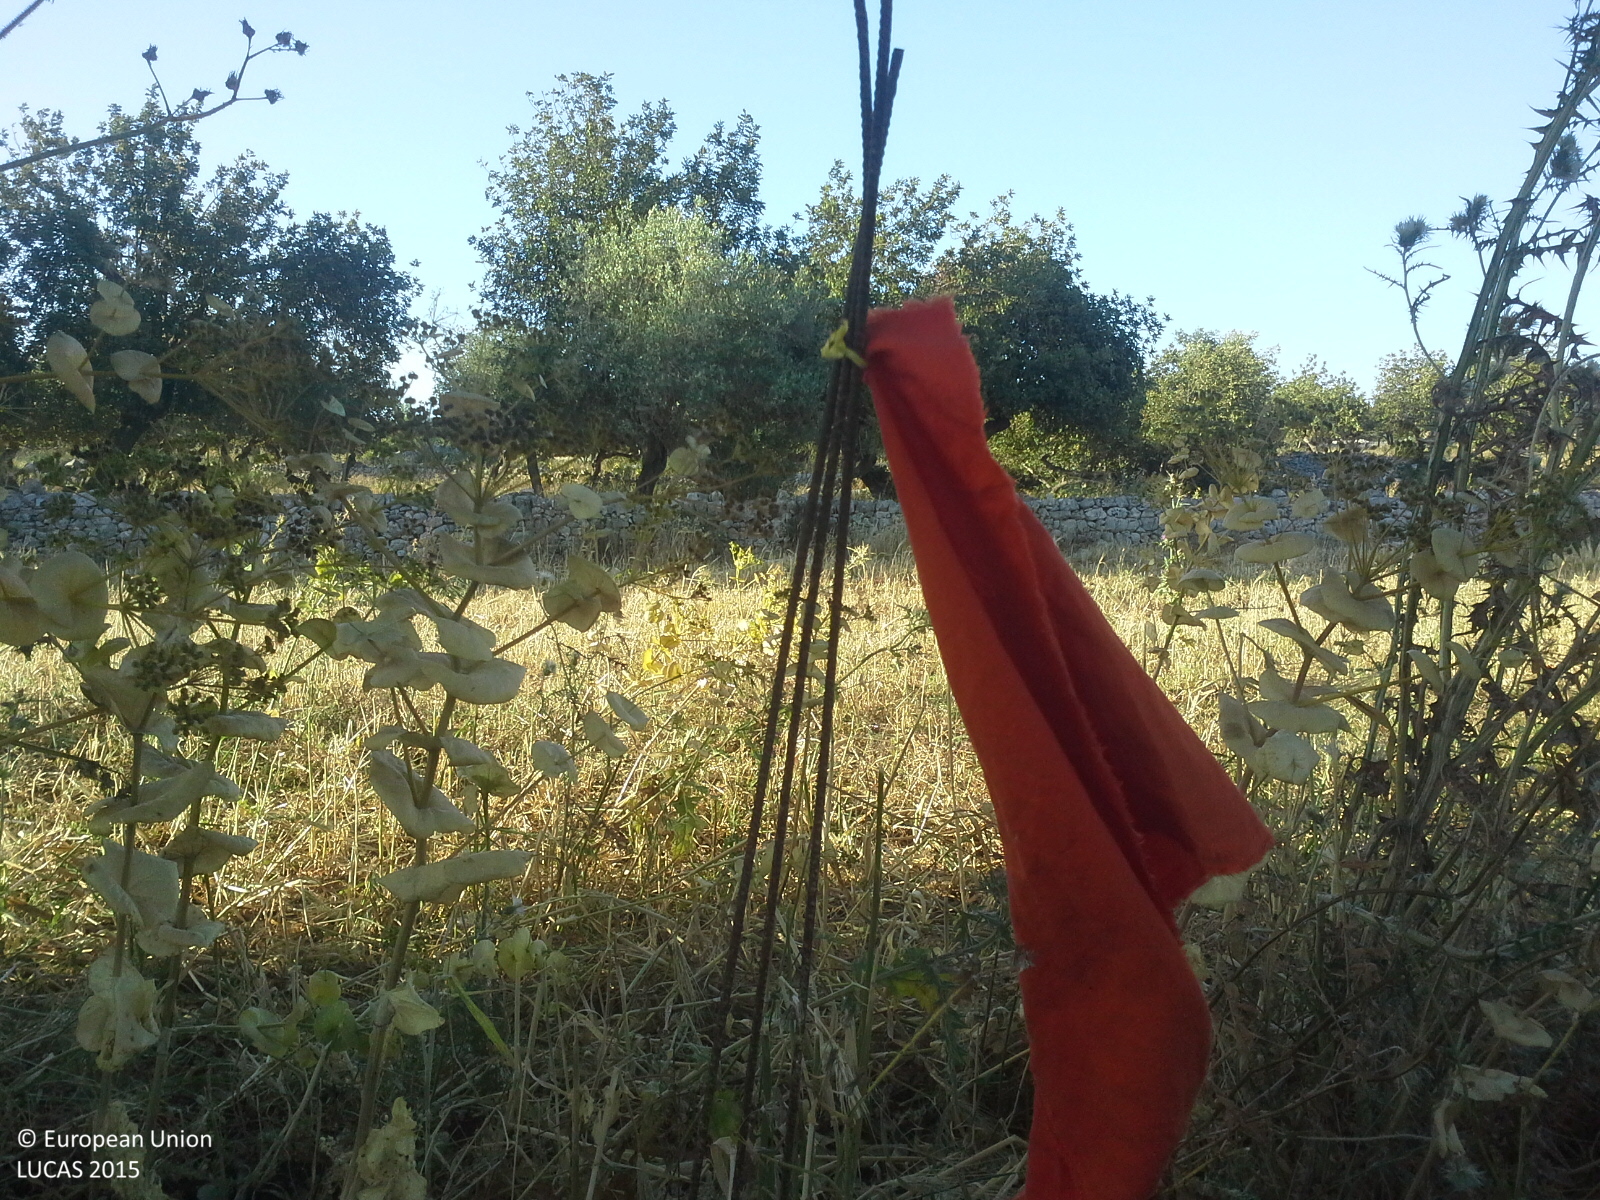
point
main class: Cropland
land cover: Permanent industrial crops
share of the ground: > 75 %
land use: Agriculture (excluding fallow land and kitchen gardens)
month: May
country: IT
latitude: 36.7866
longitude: 14.8578
